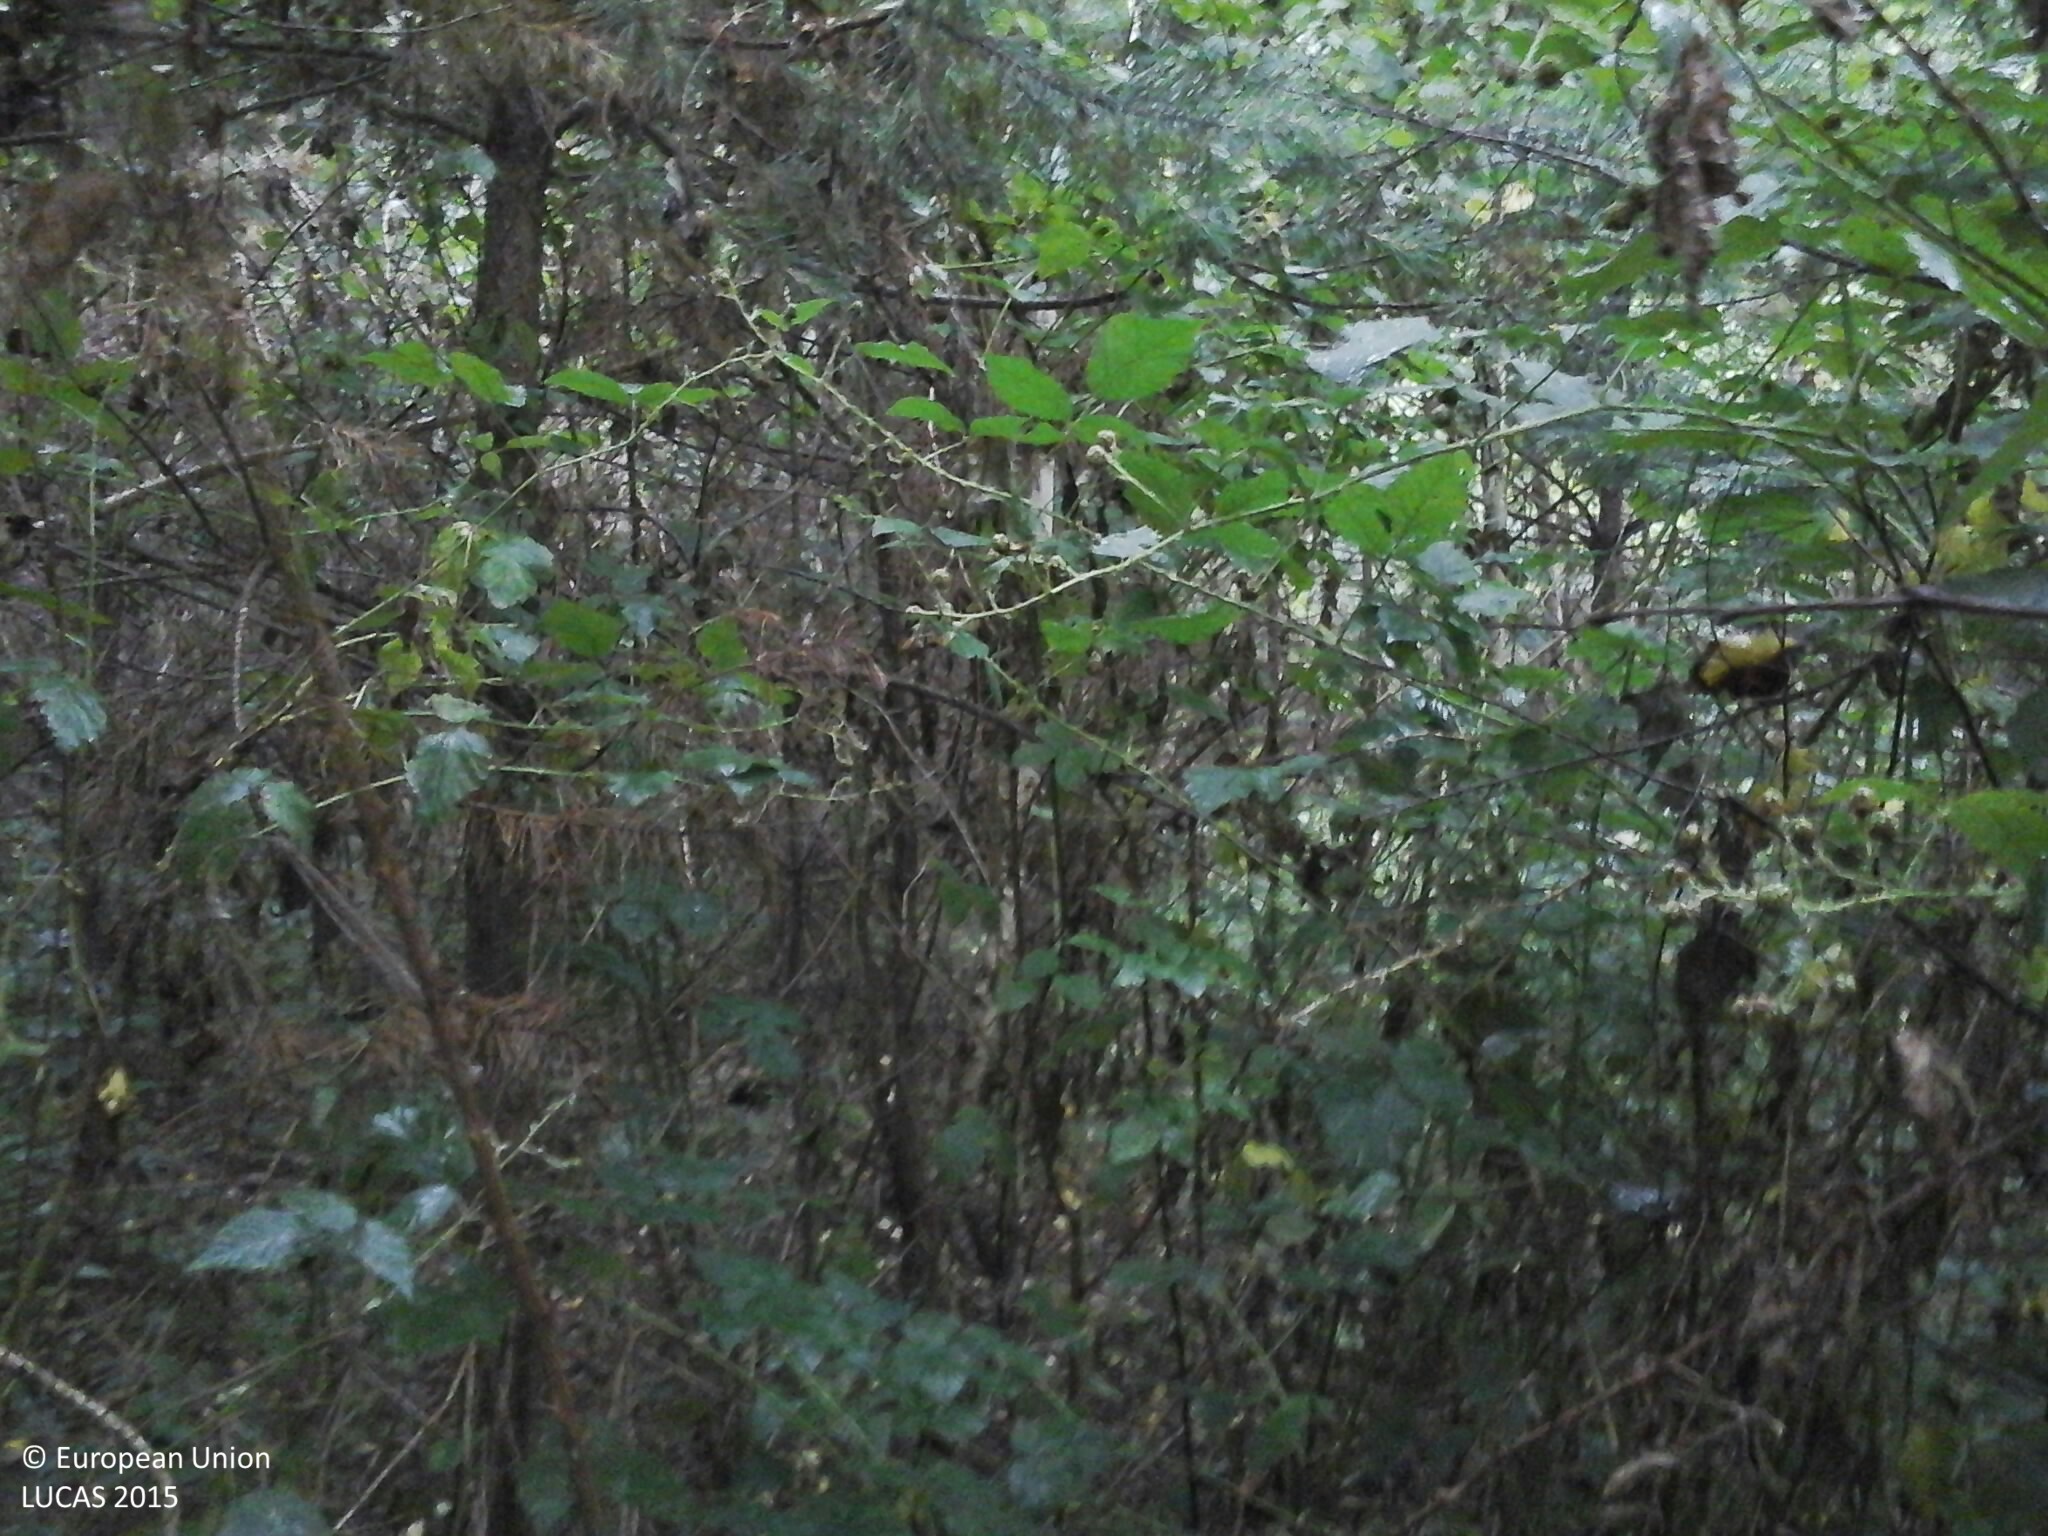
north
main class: Woodland
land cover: Pine dominated coniferous woodland
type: hemiboreal forest and nemoral coniferous forest and mixed broadleaved-coniferous forest
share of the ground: 50 - 75 %
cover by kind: coniferous forest trees 55 %, shrubs 20 %, broadleaved forest trees 15 %, herbaceous plants 10 %
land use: Forestry
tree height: < 5 m
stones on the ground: < 10 %
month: July
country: HU
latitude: 46.7866
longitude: 16.4860
